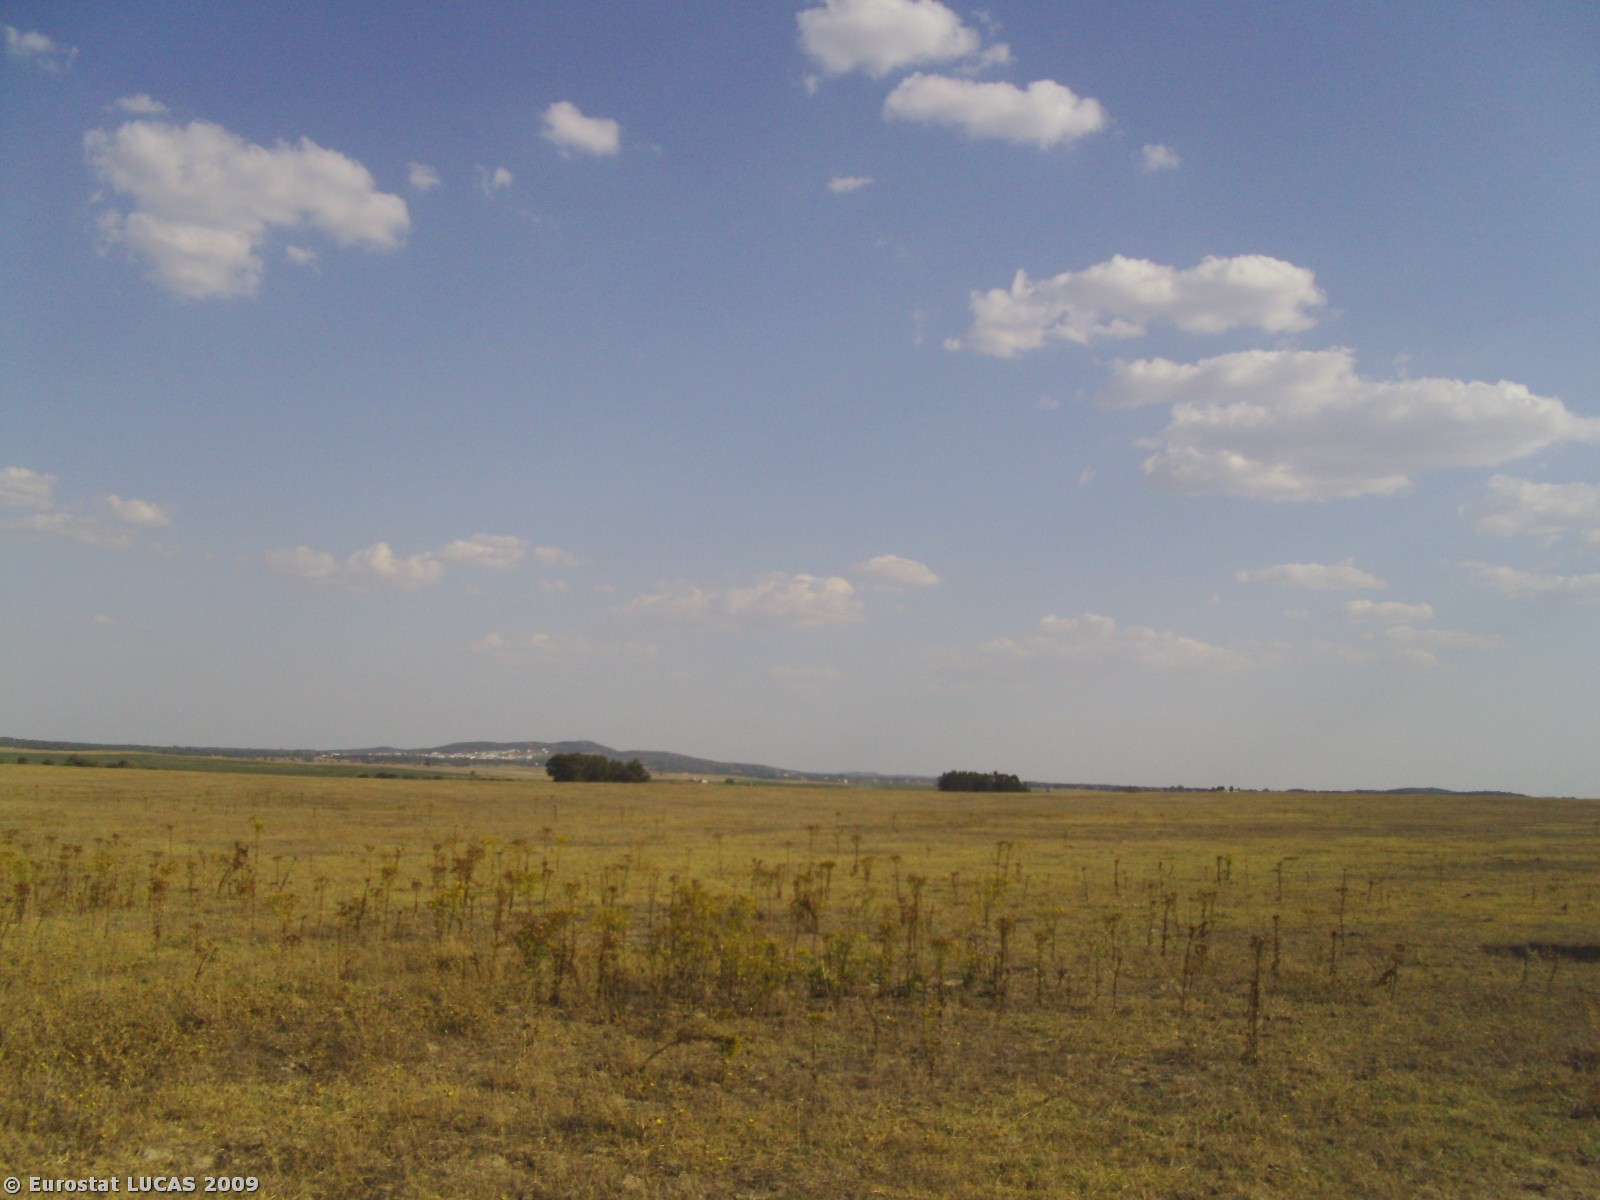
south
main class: Grassland
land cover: Grassland without tree/shrub cover
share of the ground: > 75 %
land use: Agriculture (excluding fallow land and kitchen gardens)
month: August
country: PT
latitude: 38.3926
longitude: -8.0494
